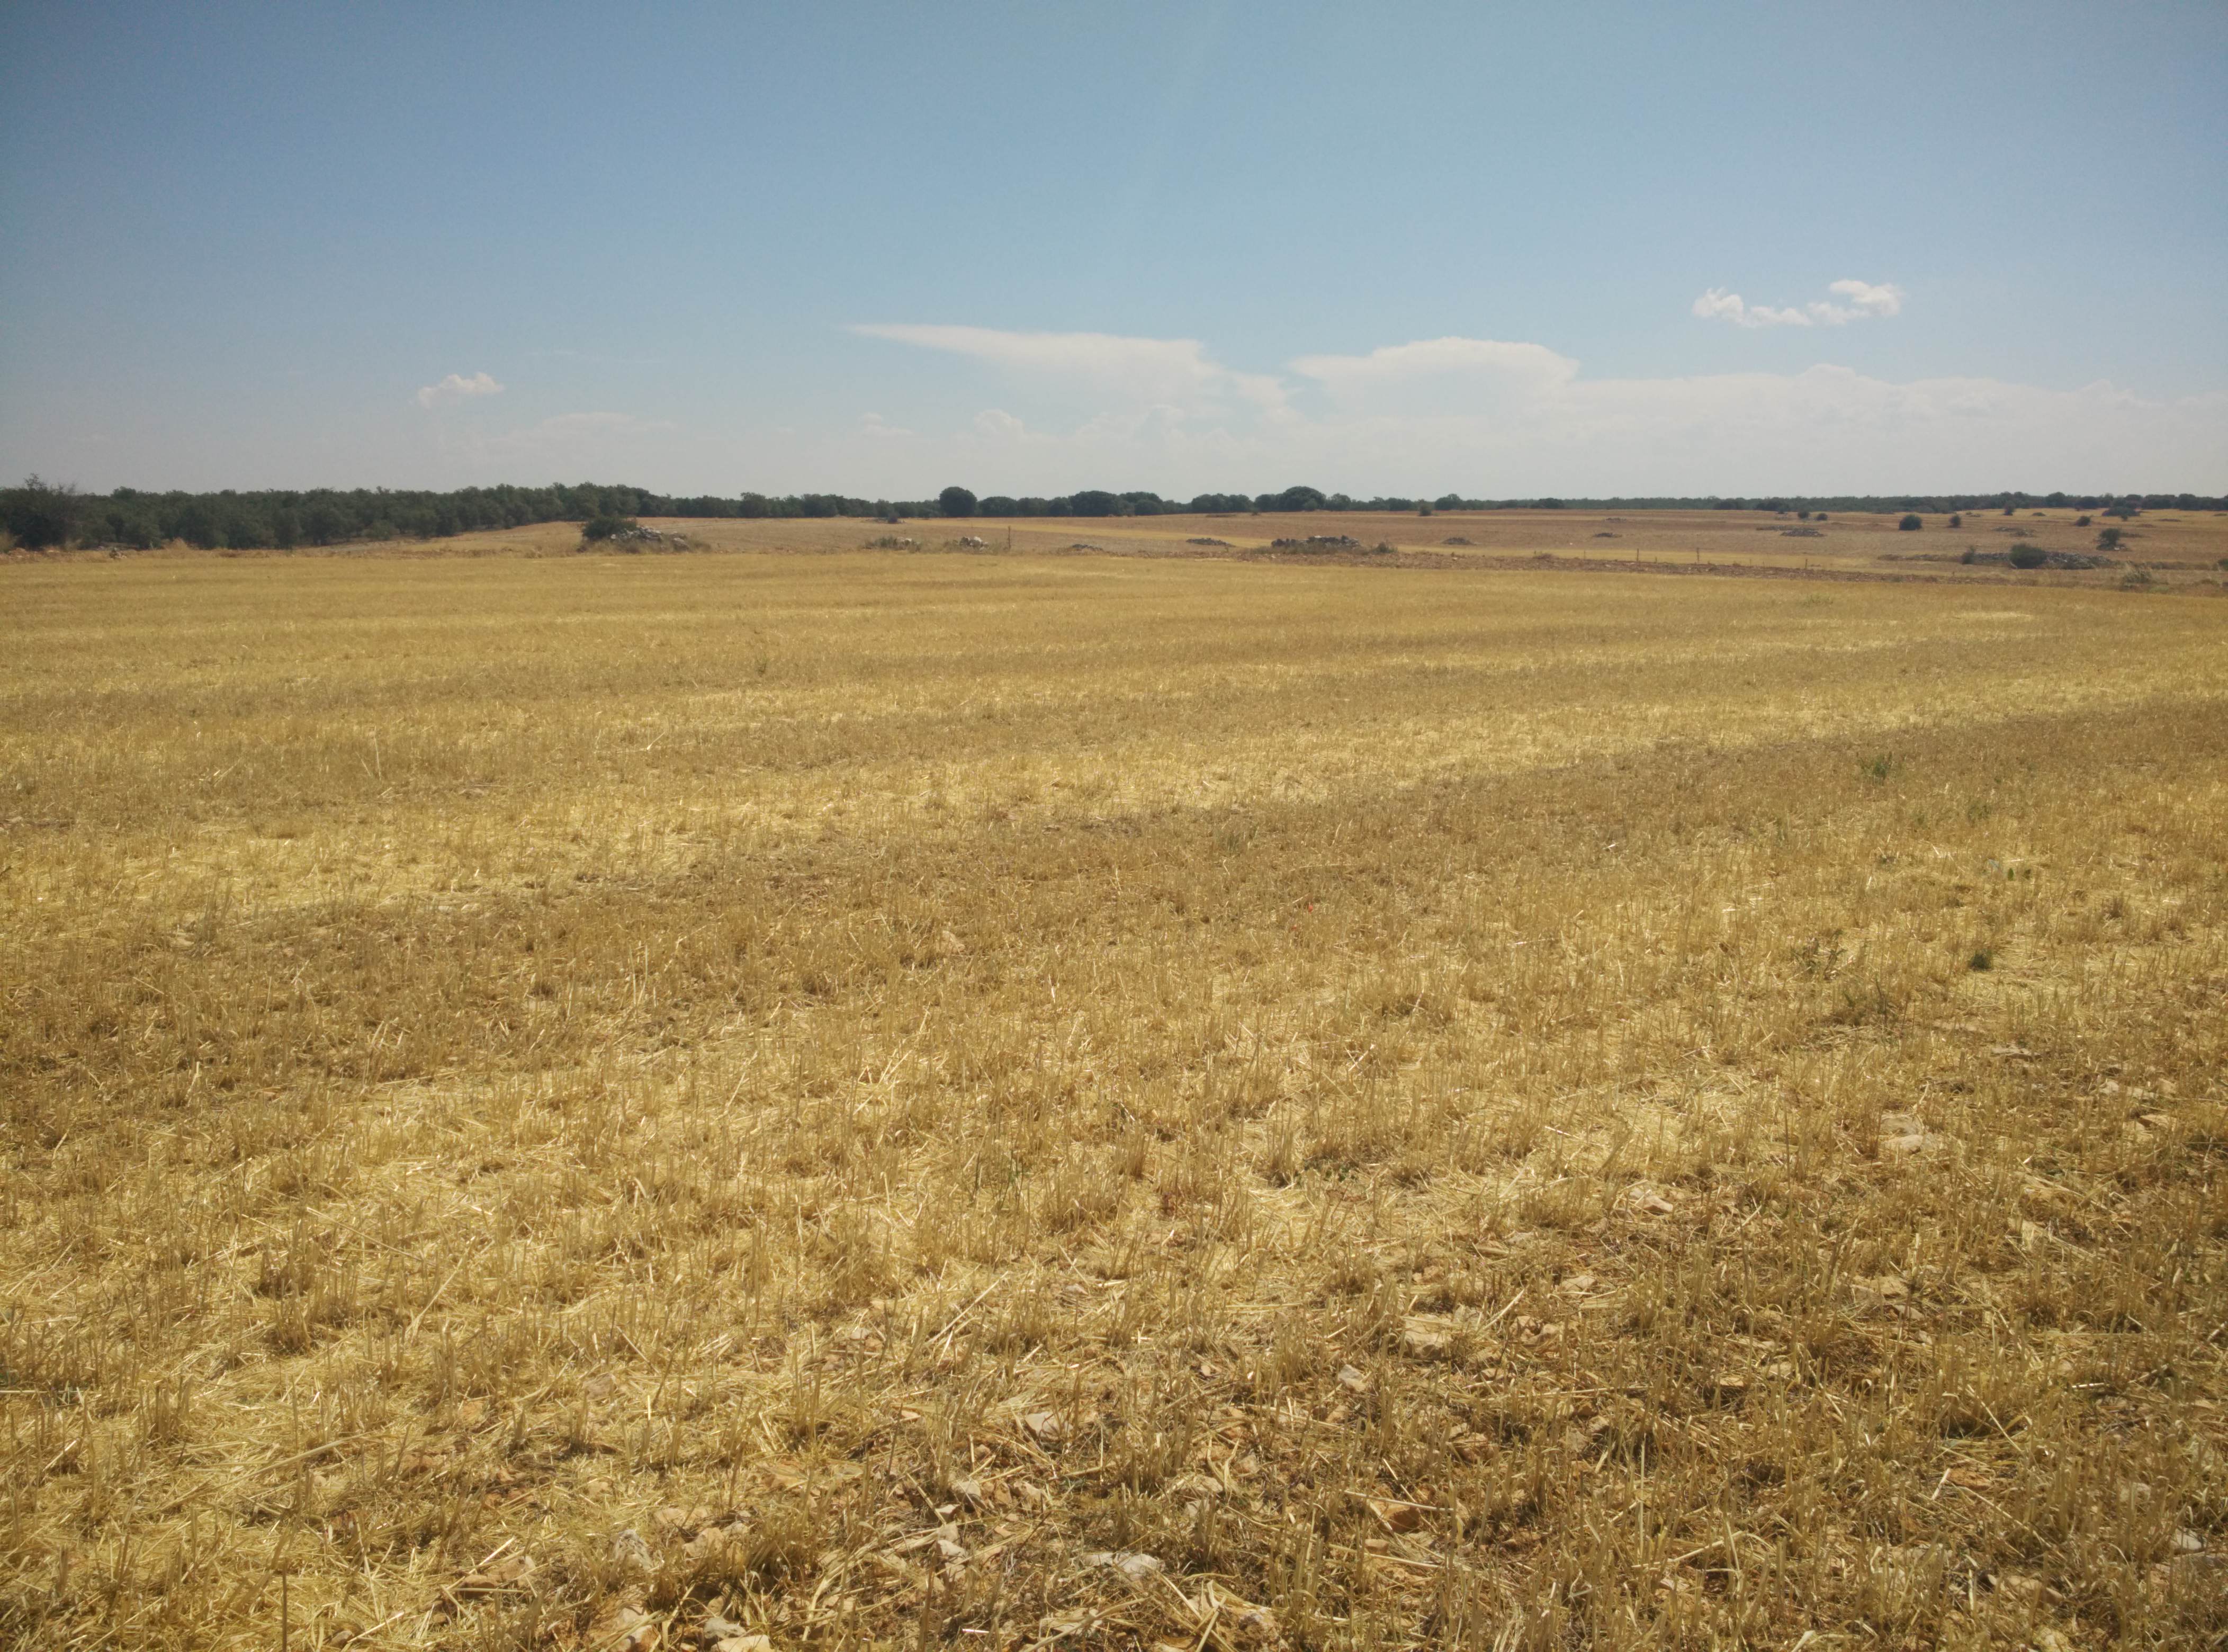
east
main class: Cropland
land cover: Barley
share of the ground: < 10 %
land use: Agriculture (excluding fallow land and kitchen gardens)
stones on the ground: > 50 %
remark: Harvested field
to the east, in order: Barley; Dry stone walls; Other bare soil; Dry stone walls; Barley; Dry stone walls; Other bare soil; Dry stone walls; Other bare soil
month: July
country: ES
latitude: 40.9127
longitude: -2.8917
